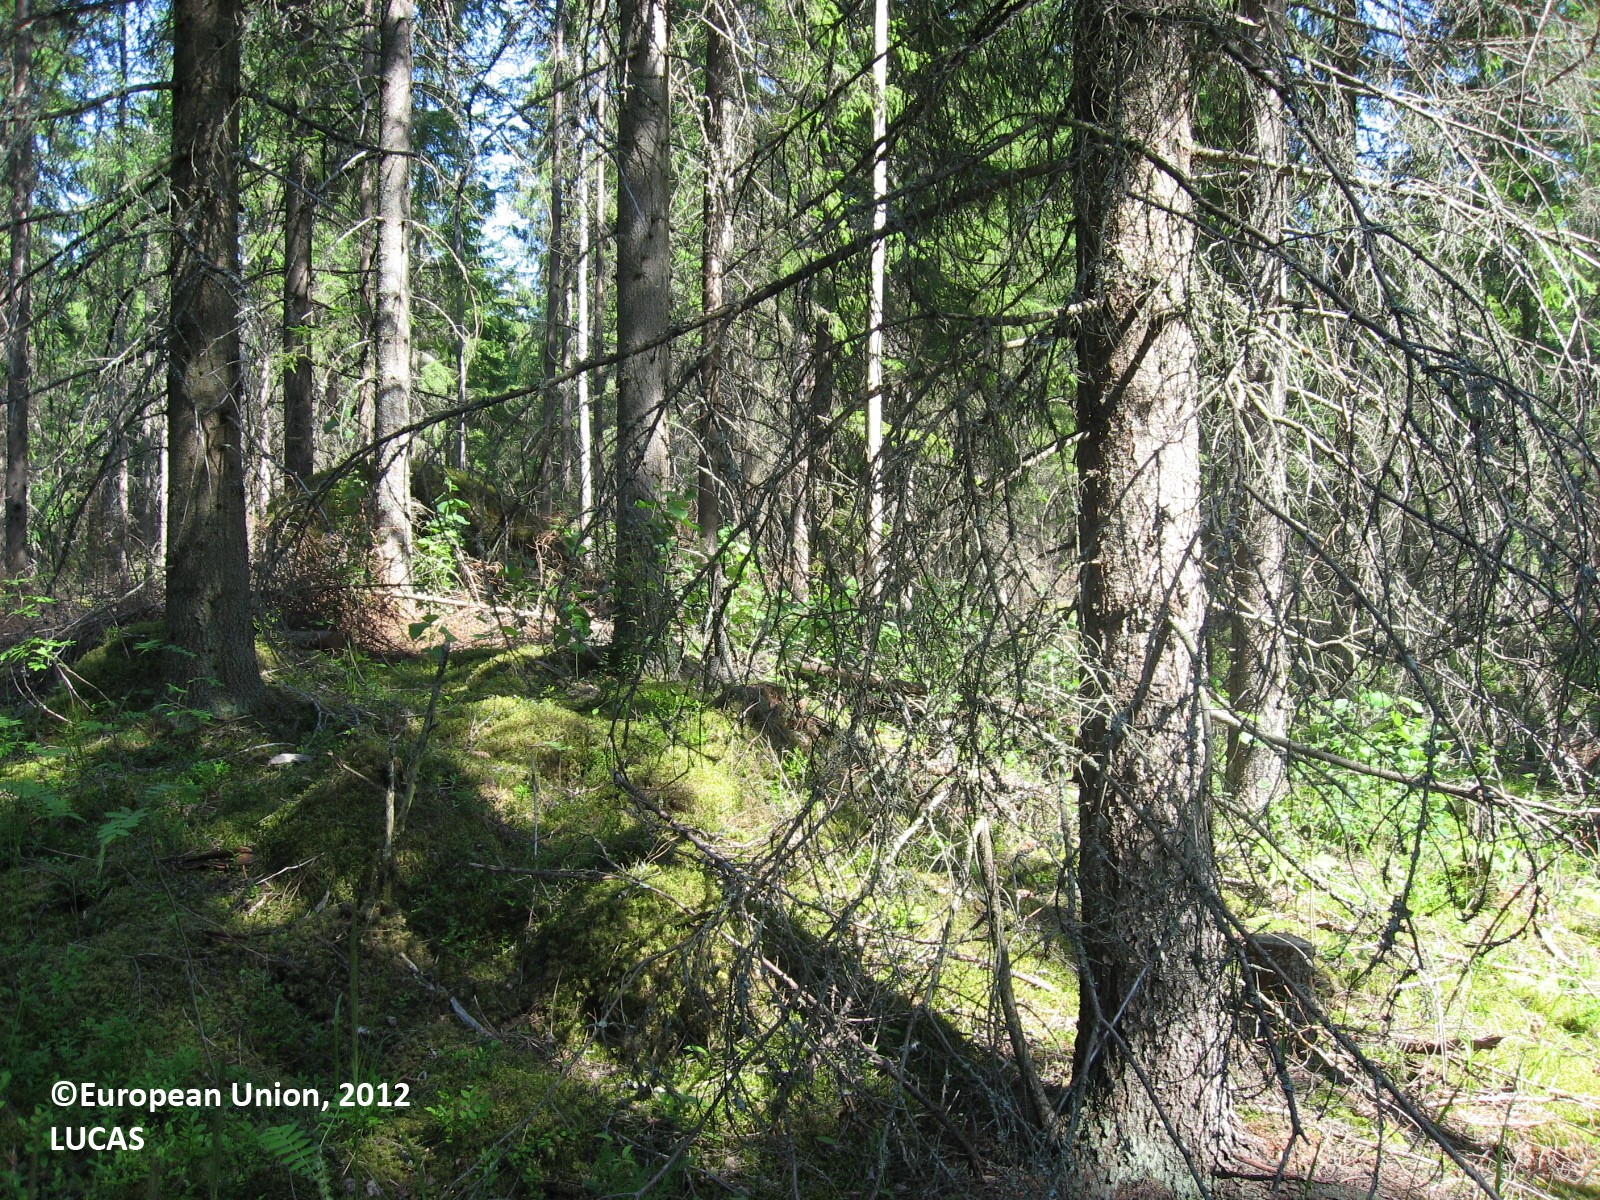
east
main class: Woodland
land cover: Spruce dominated coniferous woodland
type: boreal forest
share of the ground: 50 - 75 %
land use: Forestry
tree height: > 5 m
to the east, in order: Spruce dominated coniferous woodland; Spruce dominated mixed woodland; Spruce dominated coniferous woodland; Ditches and canals; Spruce dominated coniferous woodland; Ditches and canals; Spruce dominated coniferous woodland; Ditches and canals; Spruce dominated mixed woodland; Spruce dominated coniferous woodland
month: July
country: FI
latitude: 61.0878
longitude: 26.4481
